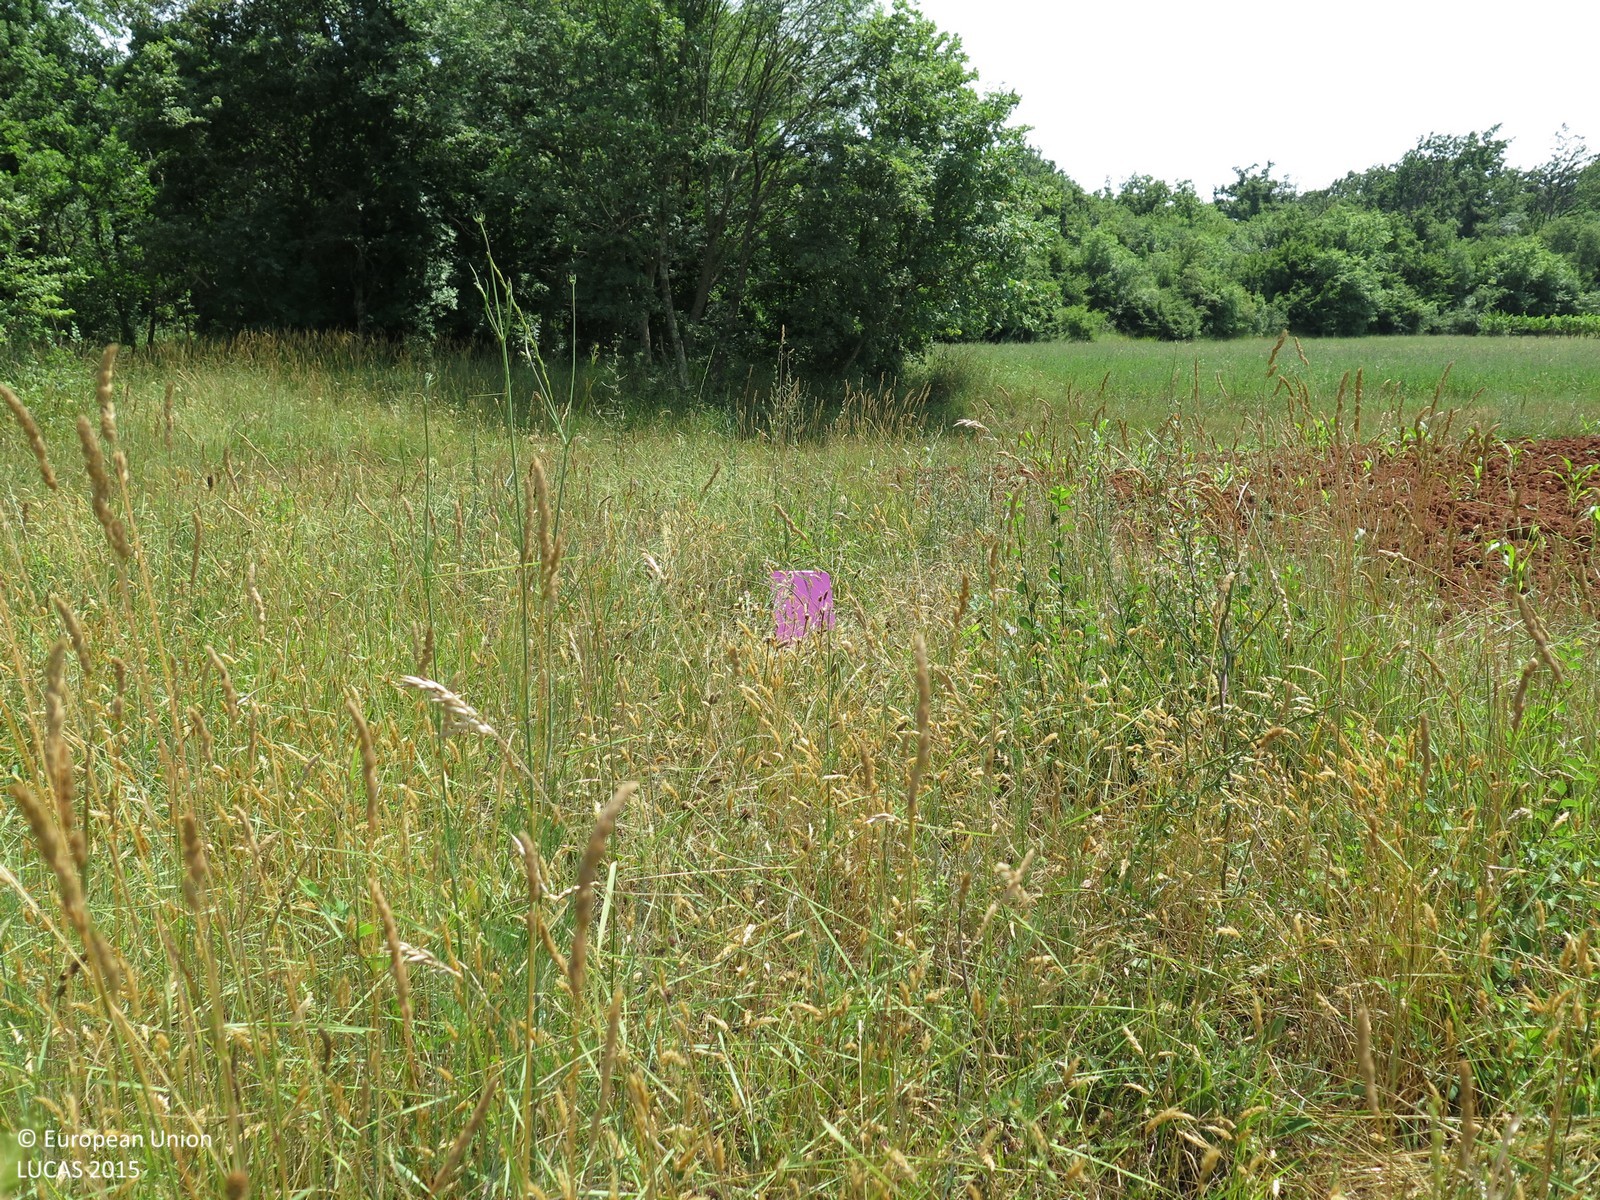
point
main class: Grassland
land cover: Grassland without tree/shrub cover
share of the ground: > 75 %
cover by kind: herbaceous plants 100 %
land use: Abandoned areas
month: June
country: HR
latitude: 45.1691
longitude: 13.6972
